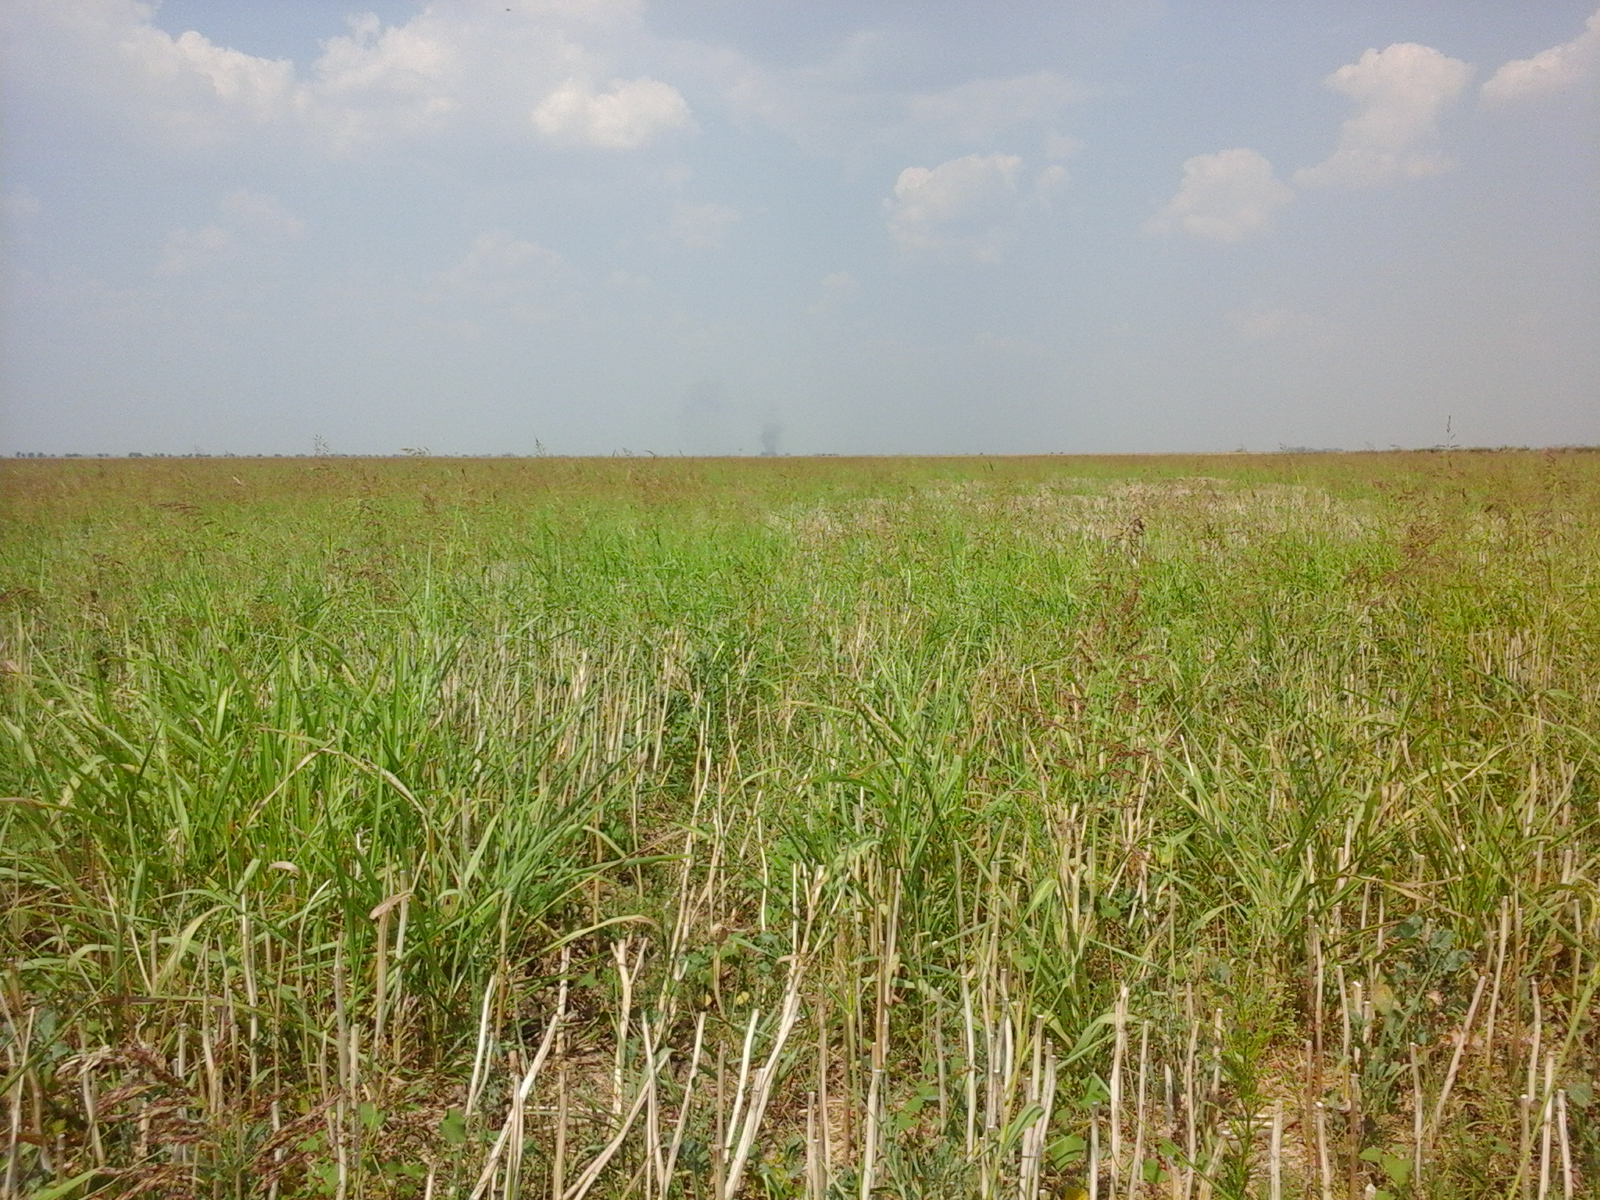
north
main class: Cropland
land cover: Rape and turnip rape
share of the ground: 10 - 25 %
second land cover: Spontaneously vegetated surfaces
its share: > 75 %
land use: Agriculture (excluding fallow land and kitchen gardens)
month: August
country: RO
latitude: 43.9415
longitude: 23.3394
